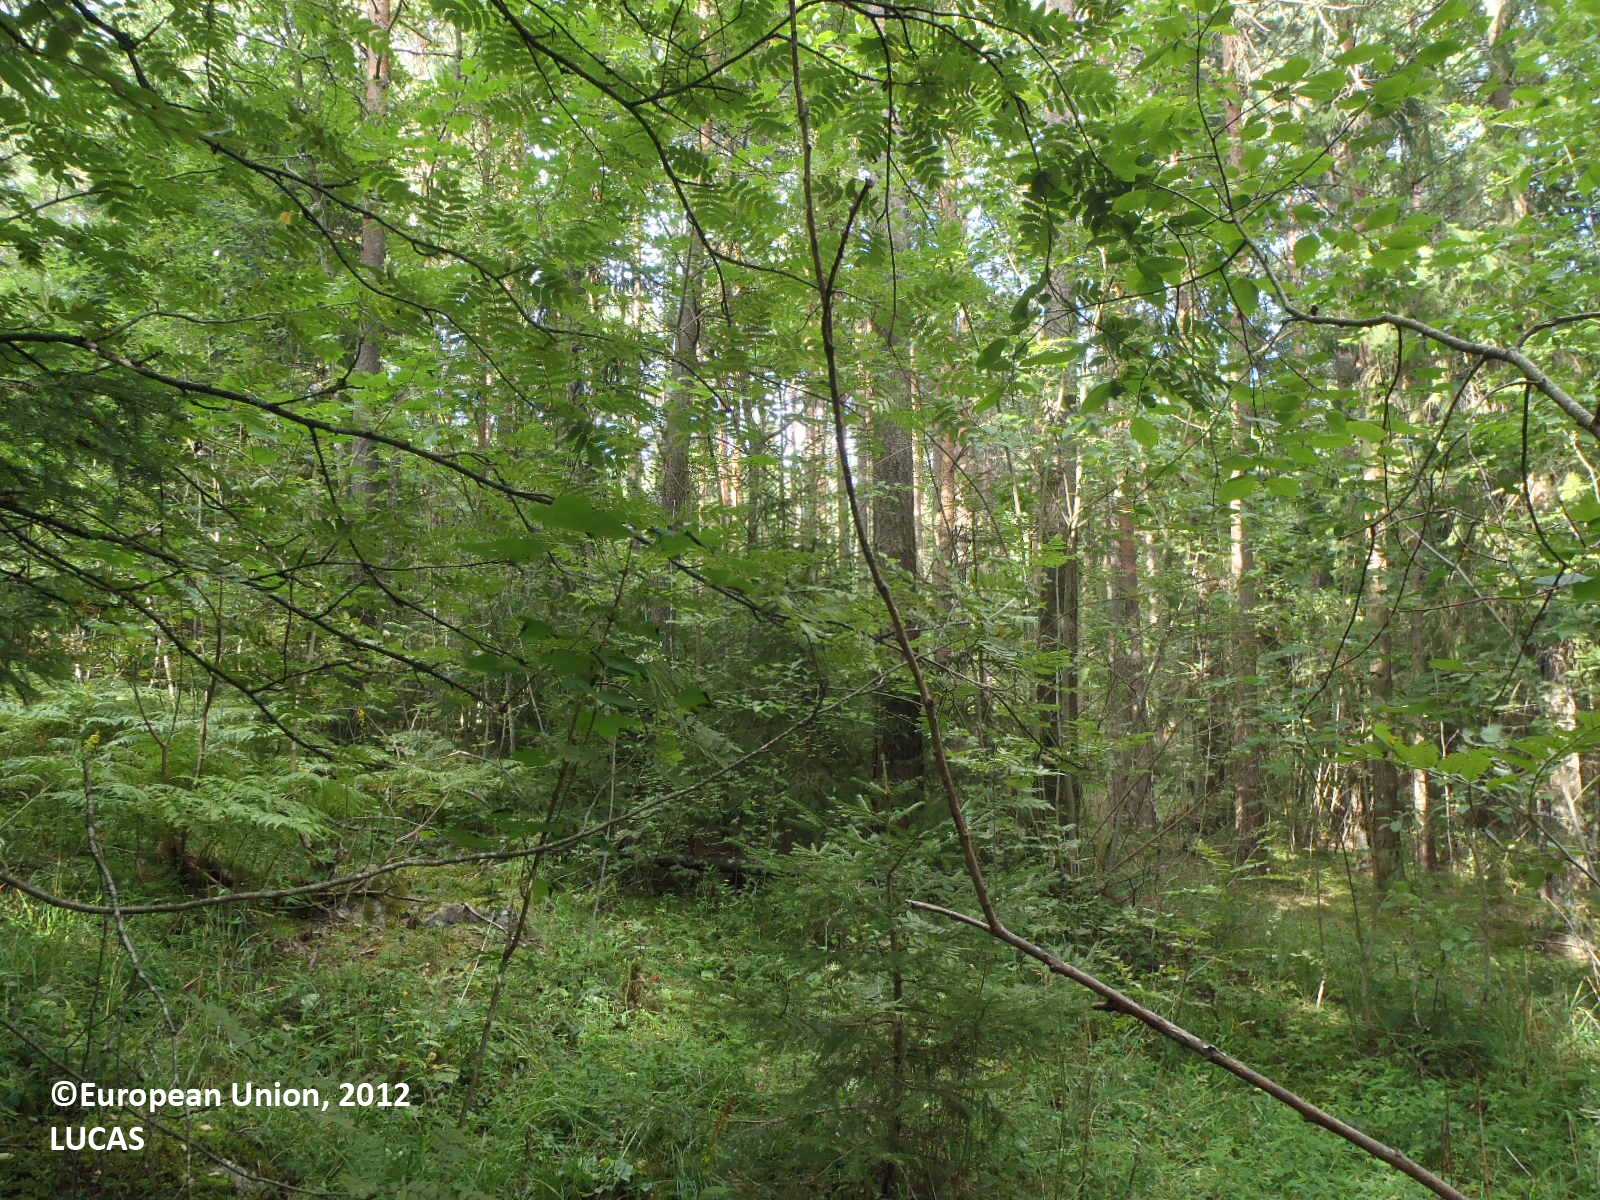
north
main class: Woodland
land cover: Spruce dominated mixed woodland
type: boreal forest
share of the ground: > 75 %
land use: Forestry
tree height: > 5 m
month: August
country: FI
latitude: 60.2955
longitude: 22.3169
